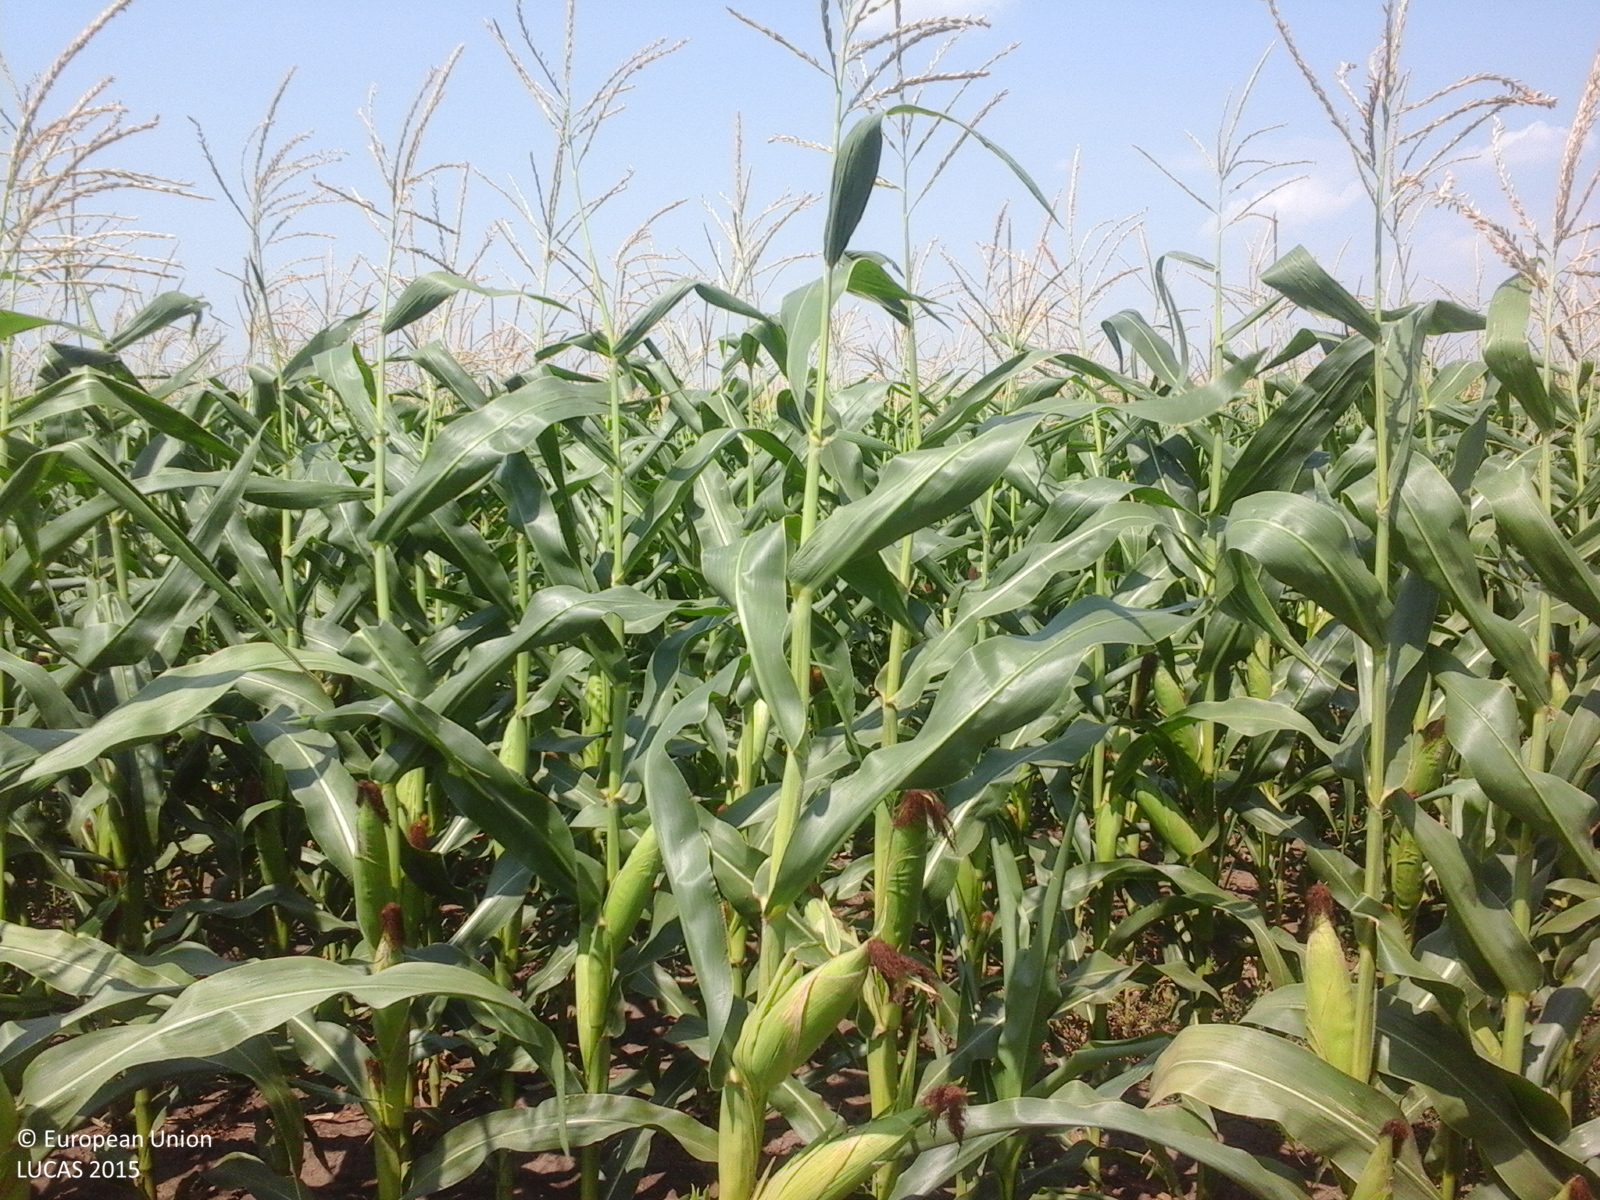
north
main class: Cropland
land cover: Maize
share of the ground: > 75 %
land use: Agriculture (excluding fallow land and kitchen gardens)
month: July
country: RO
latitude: 45.9339
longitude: 27.5576
